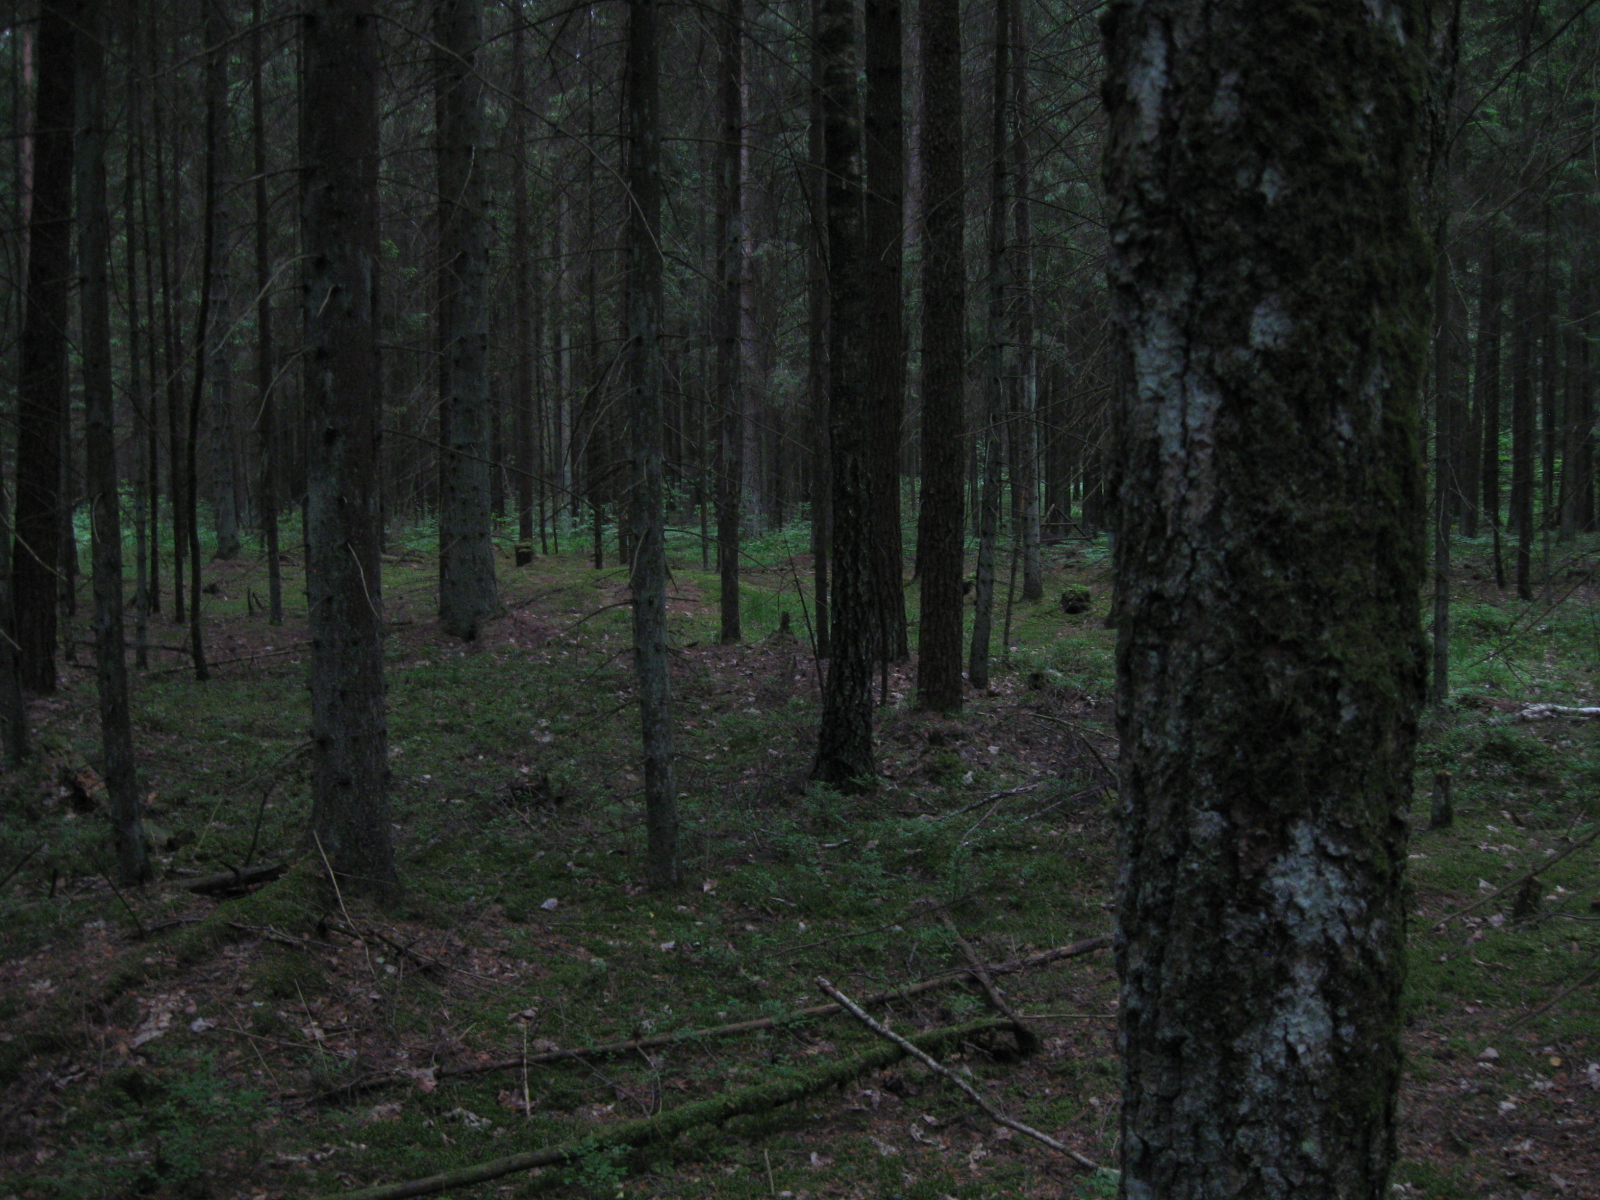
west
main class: Woodland
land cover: Spruce dominated coniferous woodland
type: hemiboreal forest and nemoral coniferous forest and mixed broadleaved-coniferous forest
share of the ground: > 75 %
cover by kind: coniferous forest trees 75 %, broadleaved forest trees 20 %, herbaceous plants 5 %
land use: Forestry
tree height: > 5 m
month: June
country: LT
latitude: 55.0166
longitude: 24.6018
